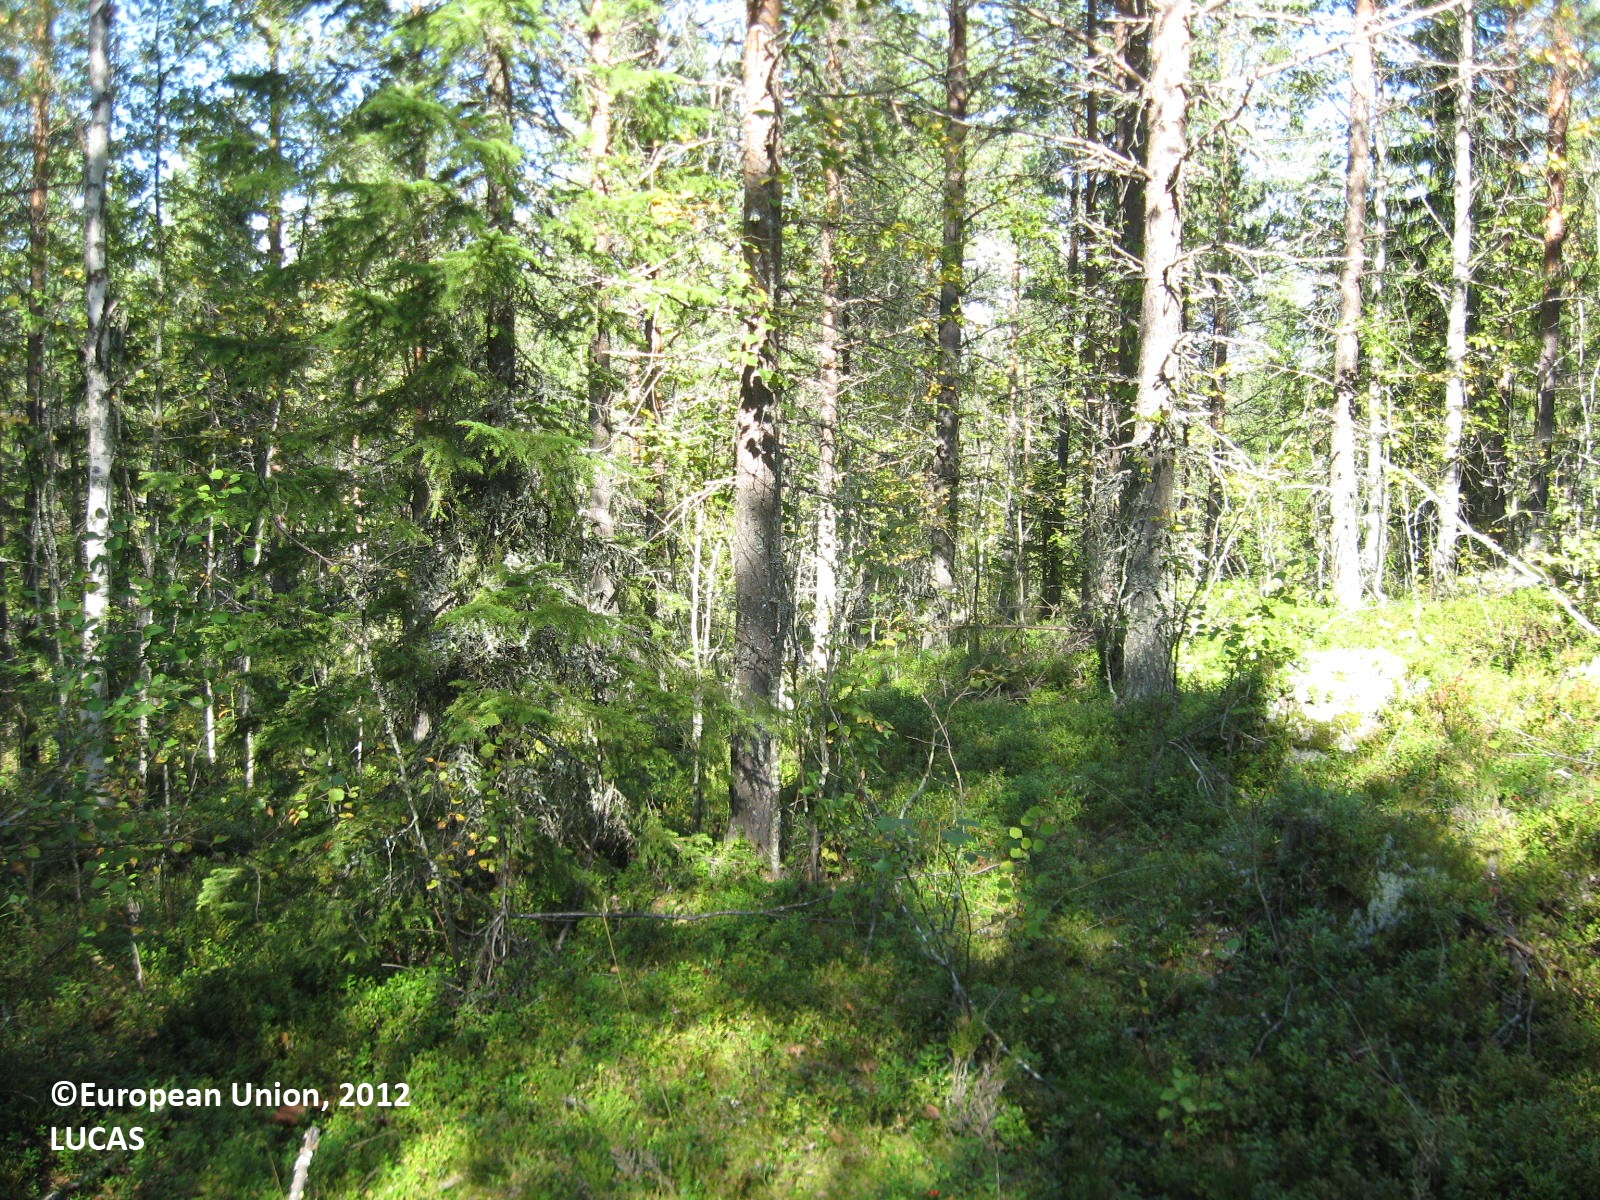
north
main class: Woodland
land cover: Pine dominated mixed woodland
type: boreal forest
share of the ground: > 75 %
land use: Forestry
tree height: > 5 m
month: August
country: FI
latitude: 63.8378
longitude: 29.3877
